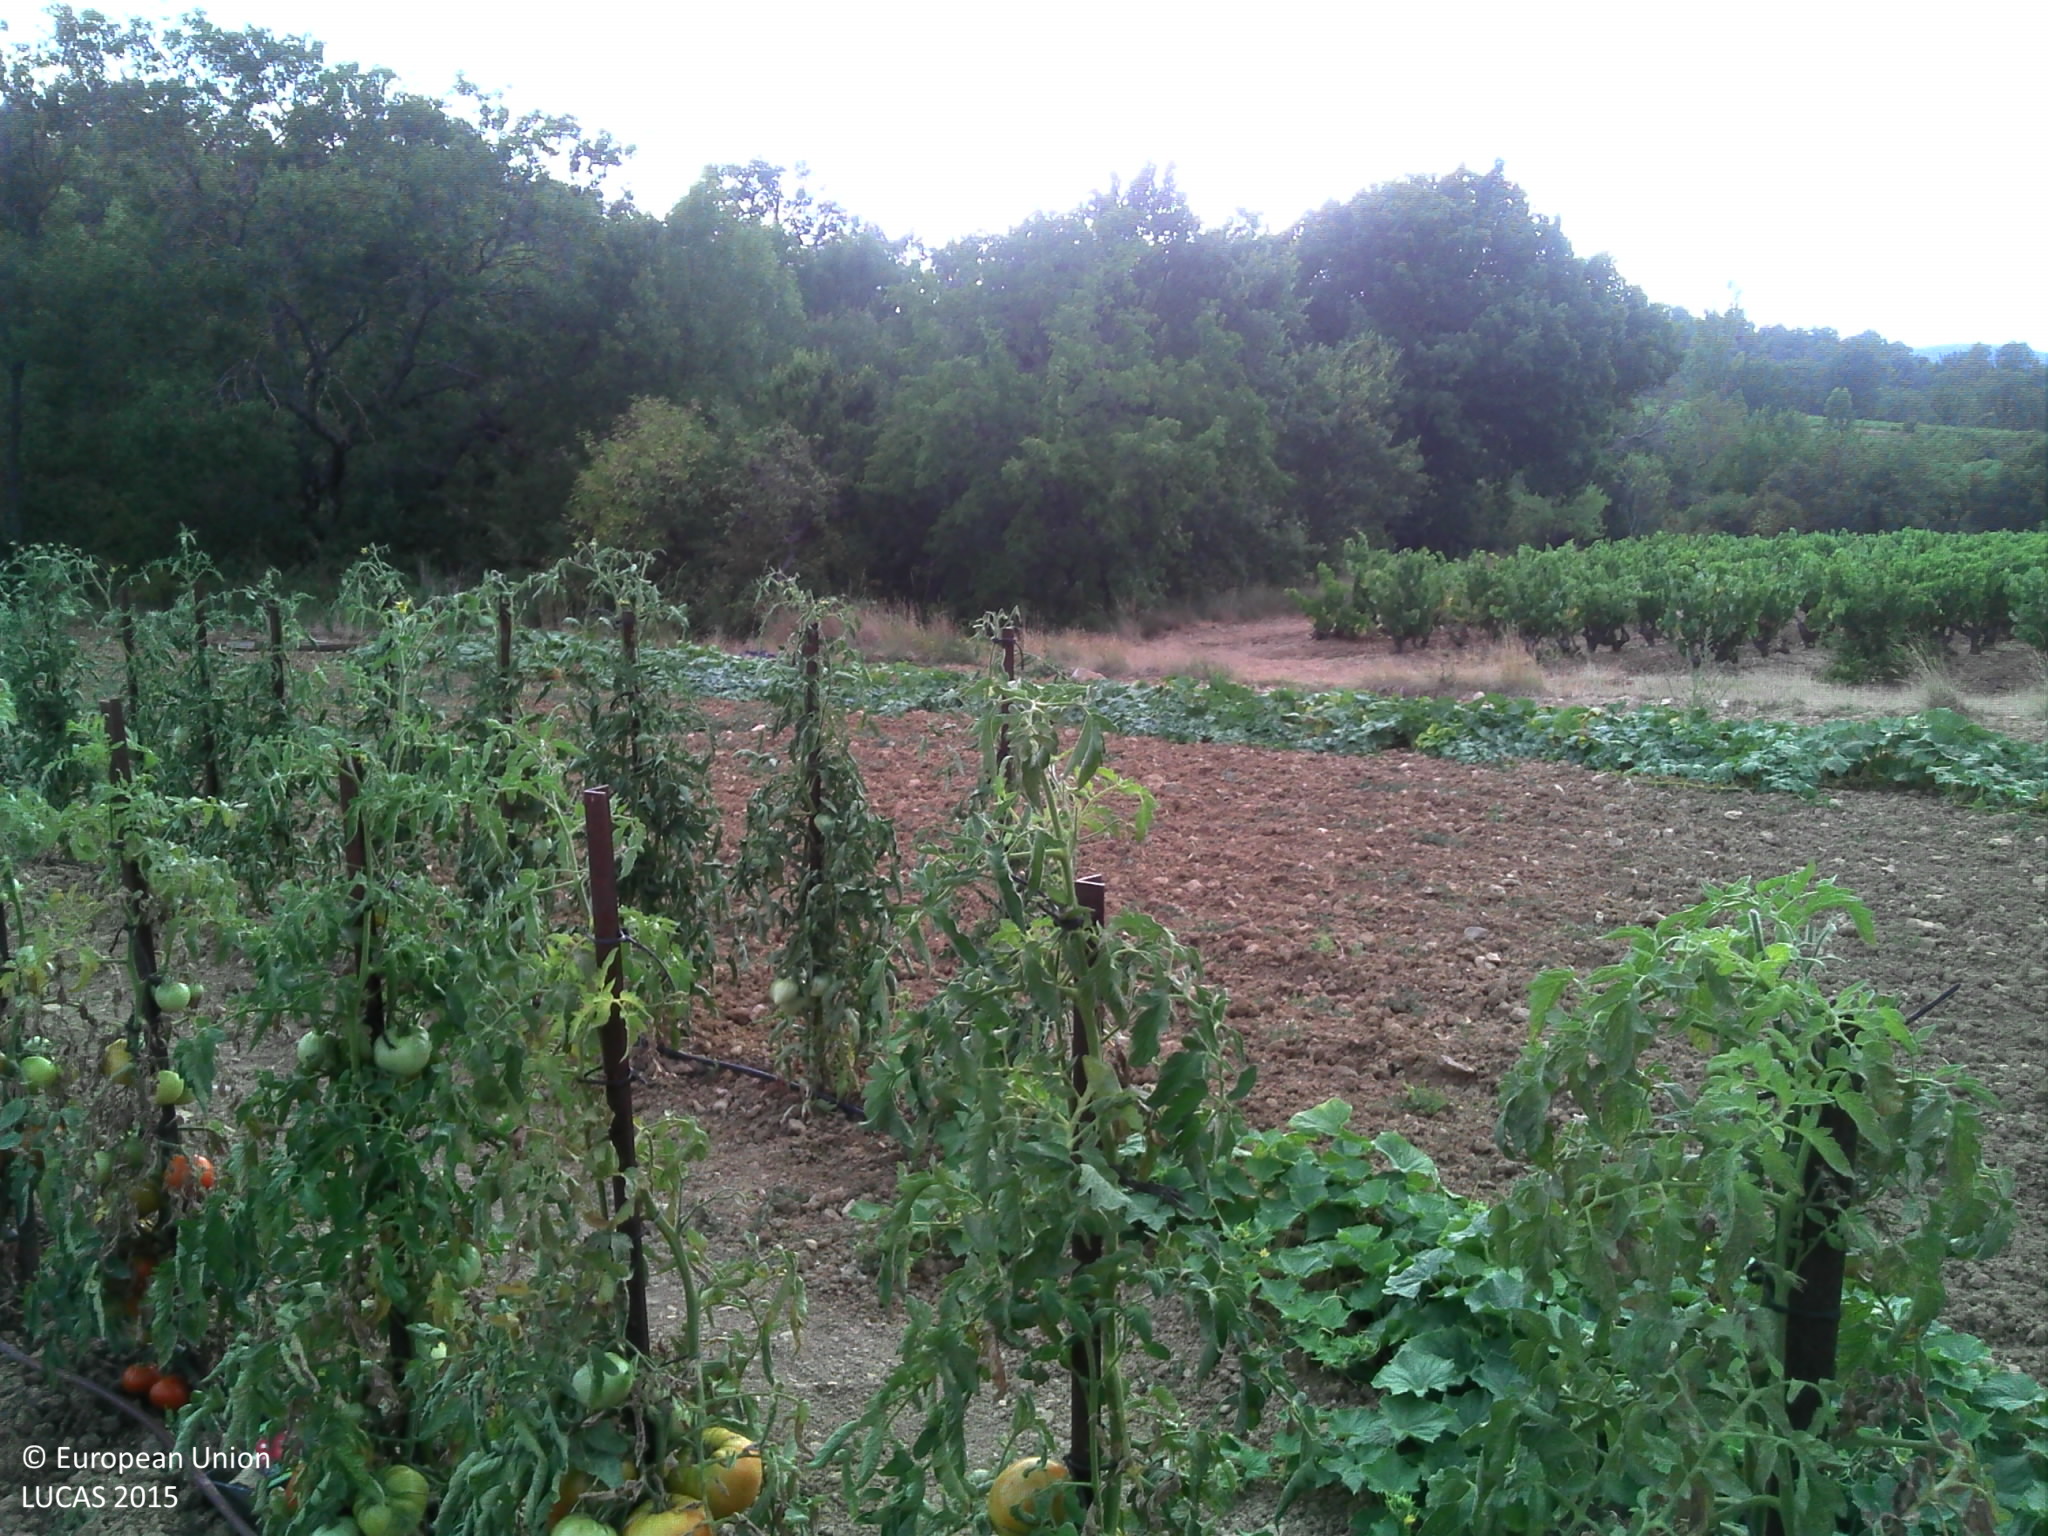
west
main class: Cropland
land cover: Tomatoes
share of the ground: 10 - 25 %
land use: Agriculture (excluding fallow land and kitchen gardens)
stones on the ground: 25 - 50 %
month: July
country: FR
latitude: 44.3399
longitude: 4.3252
